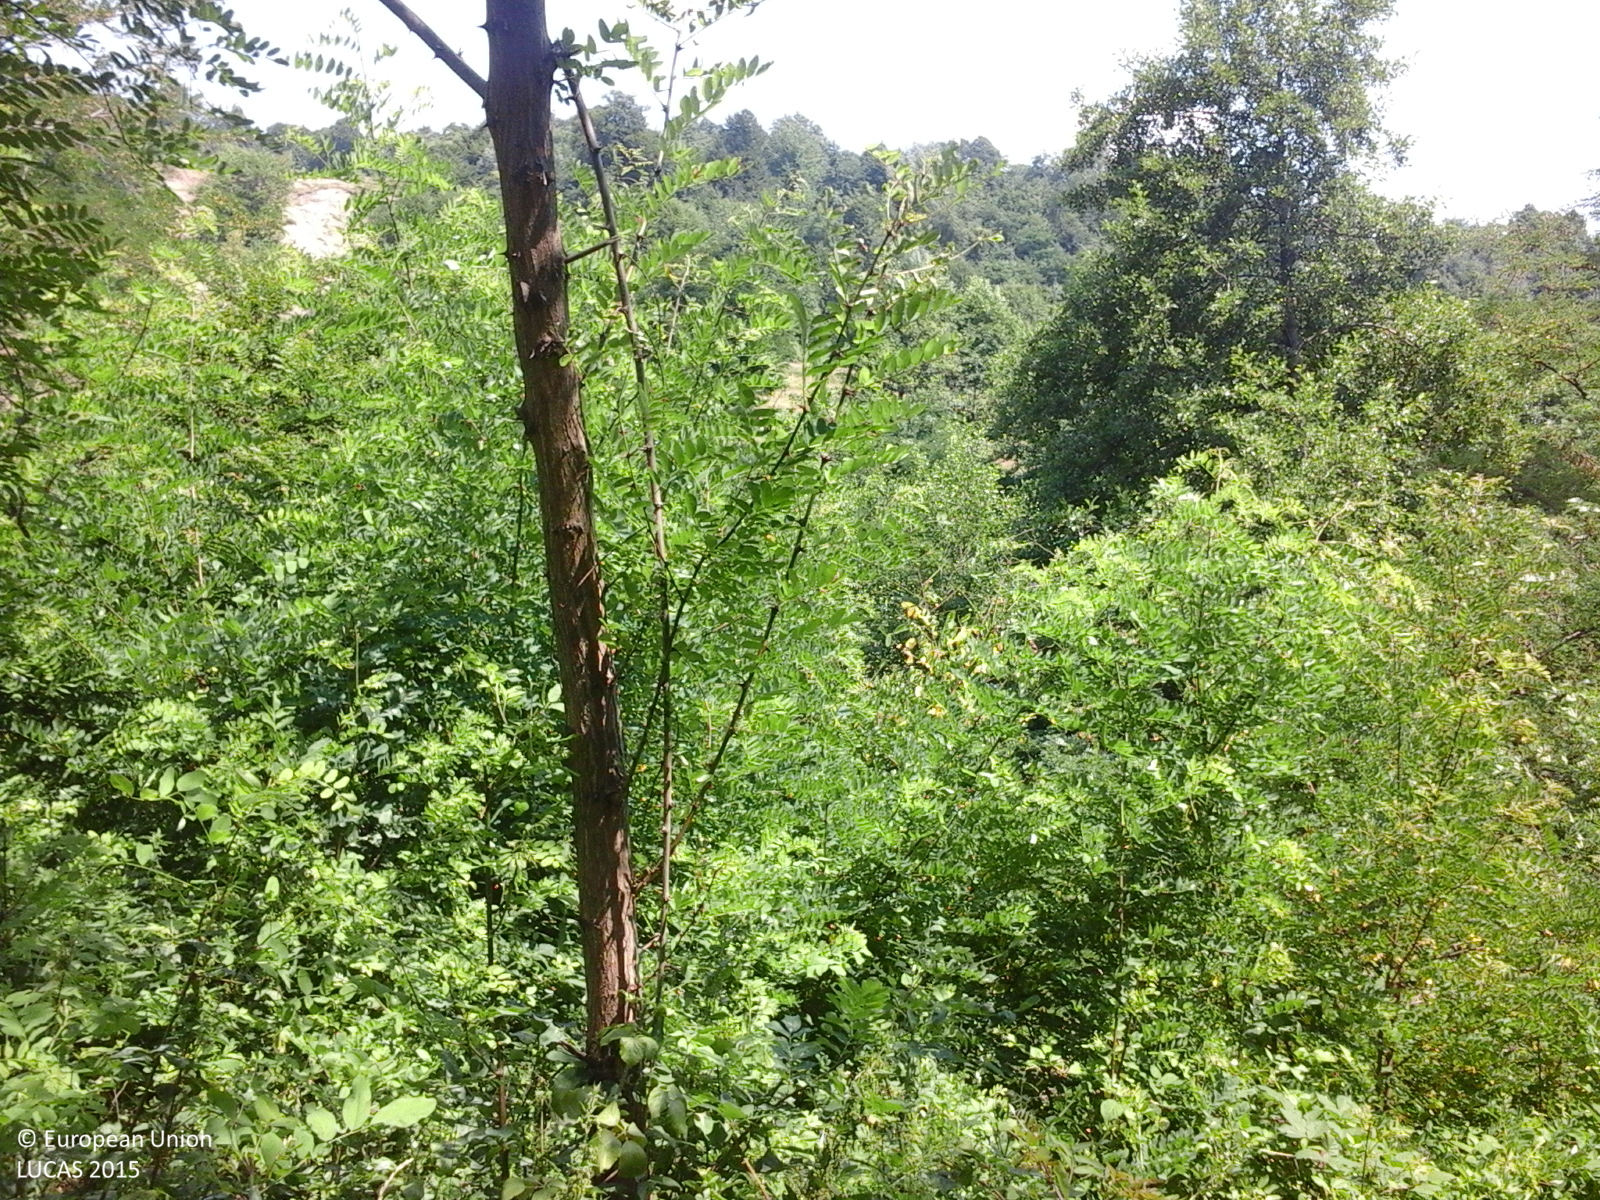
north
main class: Woodland
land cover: Broadleaved woodland
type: exotic forest
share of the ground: > 75 %
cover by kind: broadleaved forest trees 100 %
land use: Forestry
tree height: > 5 m
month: July
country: RO
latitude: 45.0408
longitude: 24.6654
